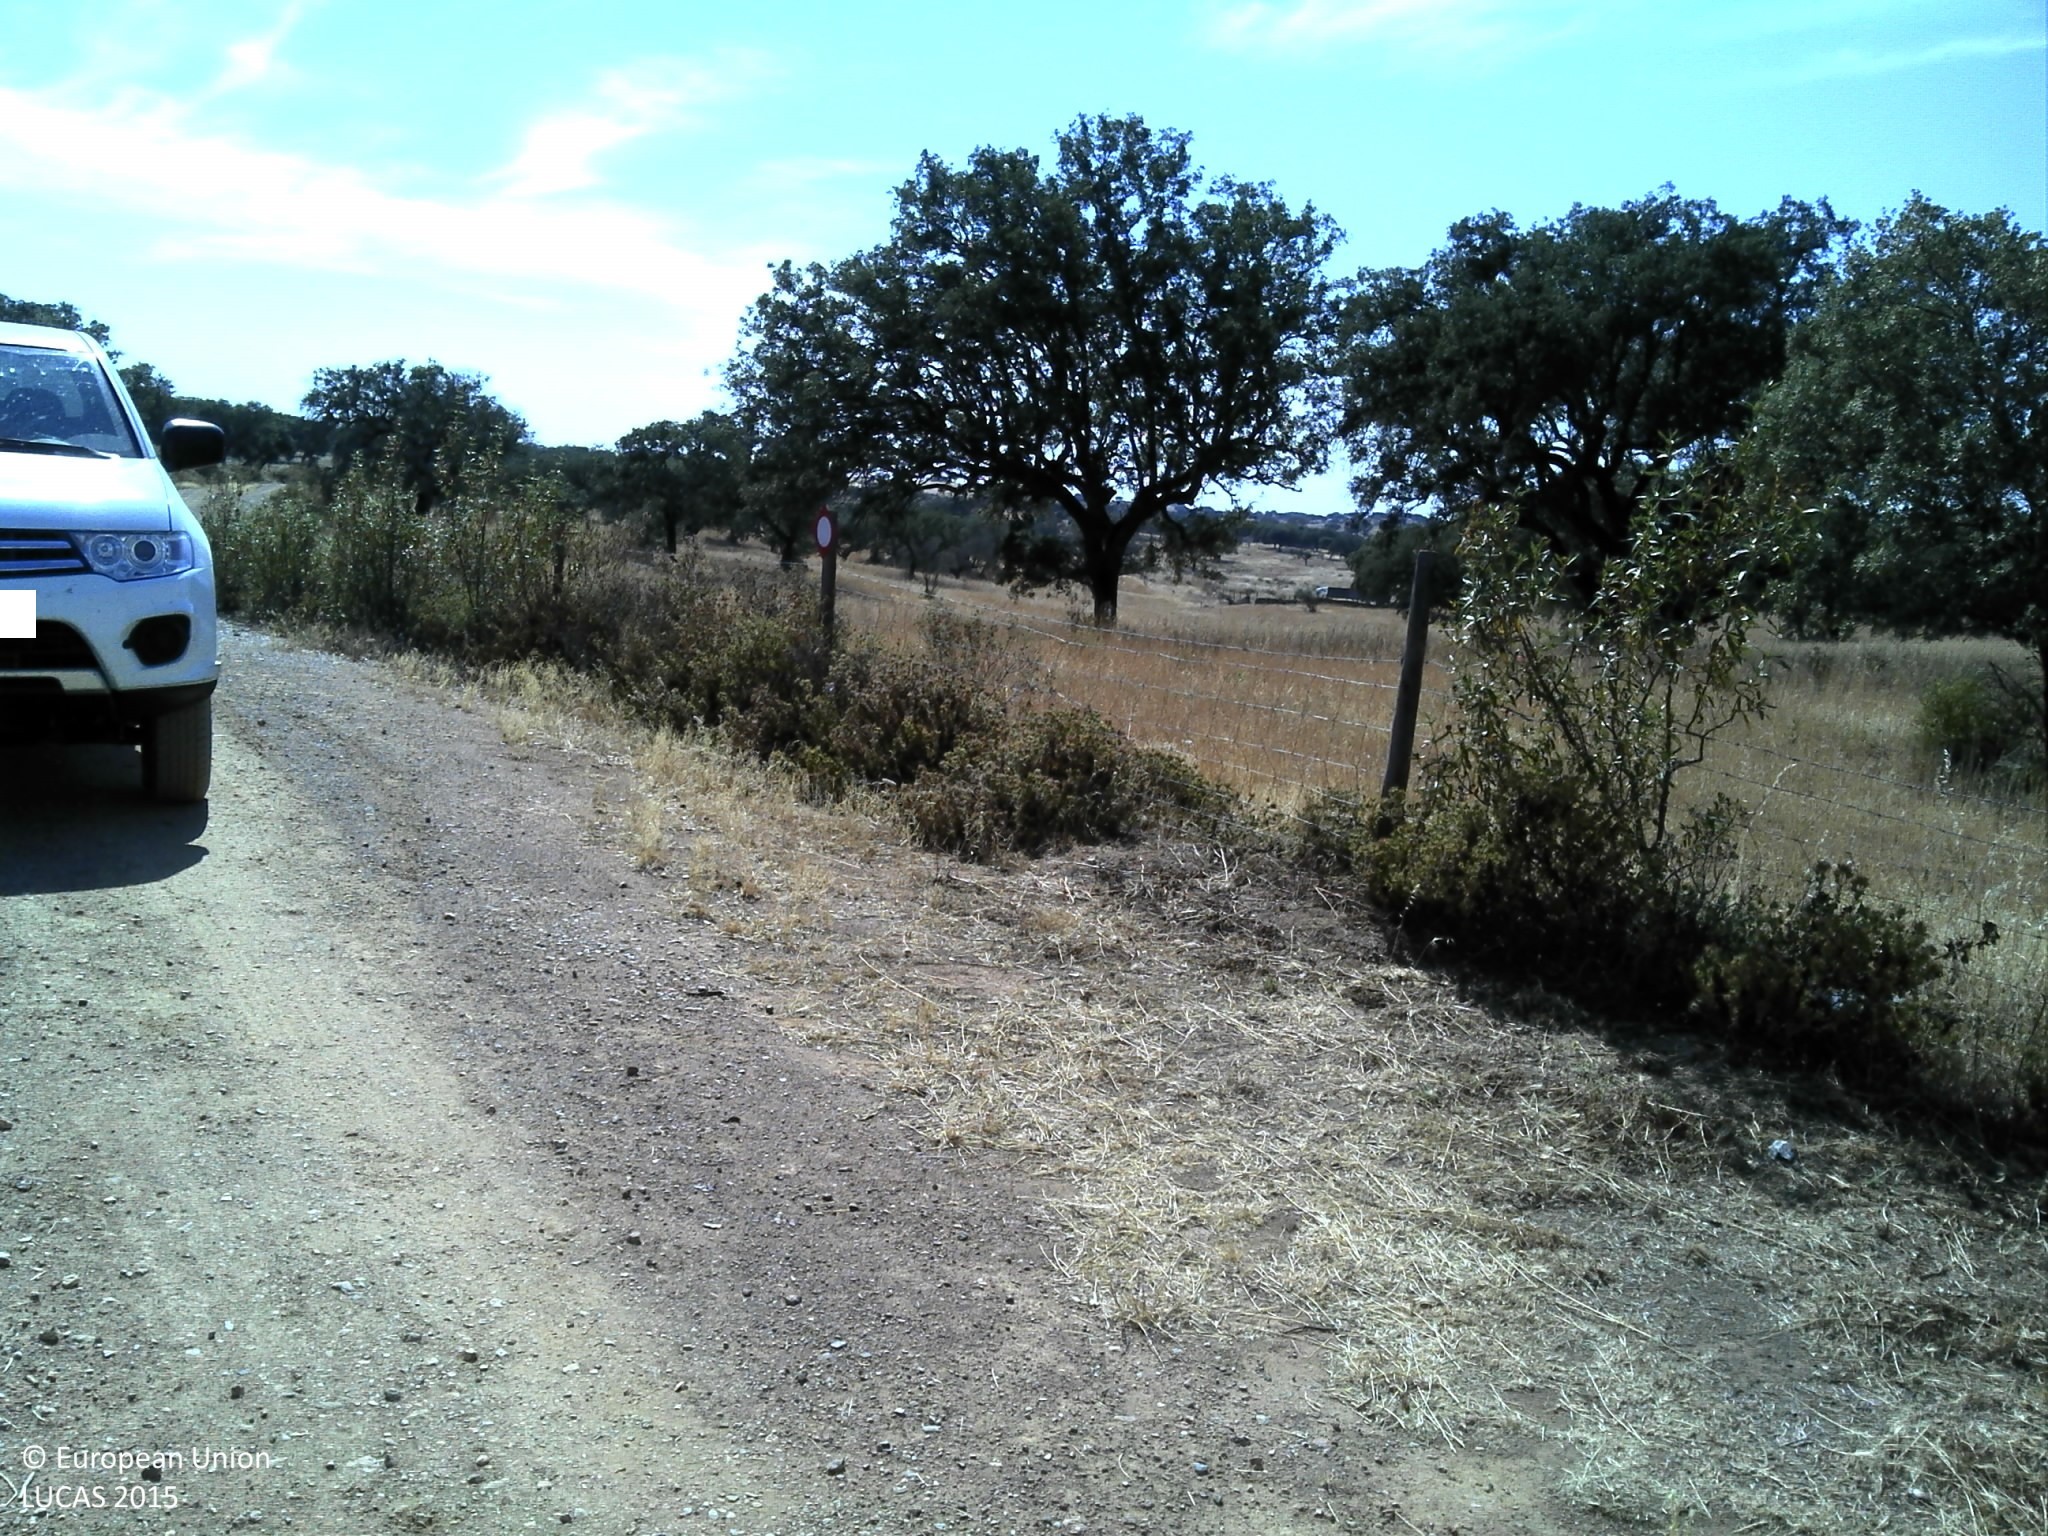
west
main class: Shrubland
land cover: Shrubland with sparse tree cover
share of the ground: > 75 %
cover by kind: shrubs 95 %, broadleaved forest trees 5 %
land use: Abandoned areas
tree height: > 5 m
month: June
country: PT
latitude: 37.6895
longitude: -7.4649
